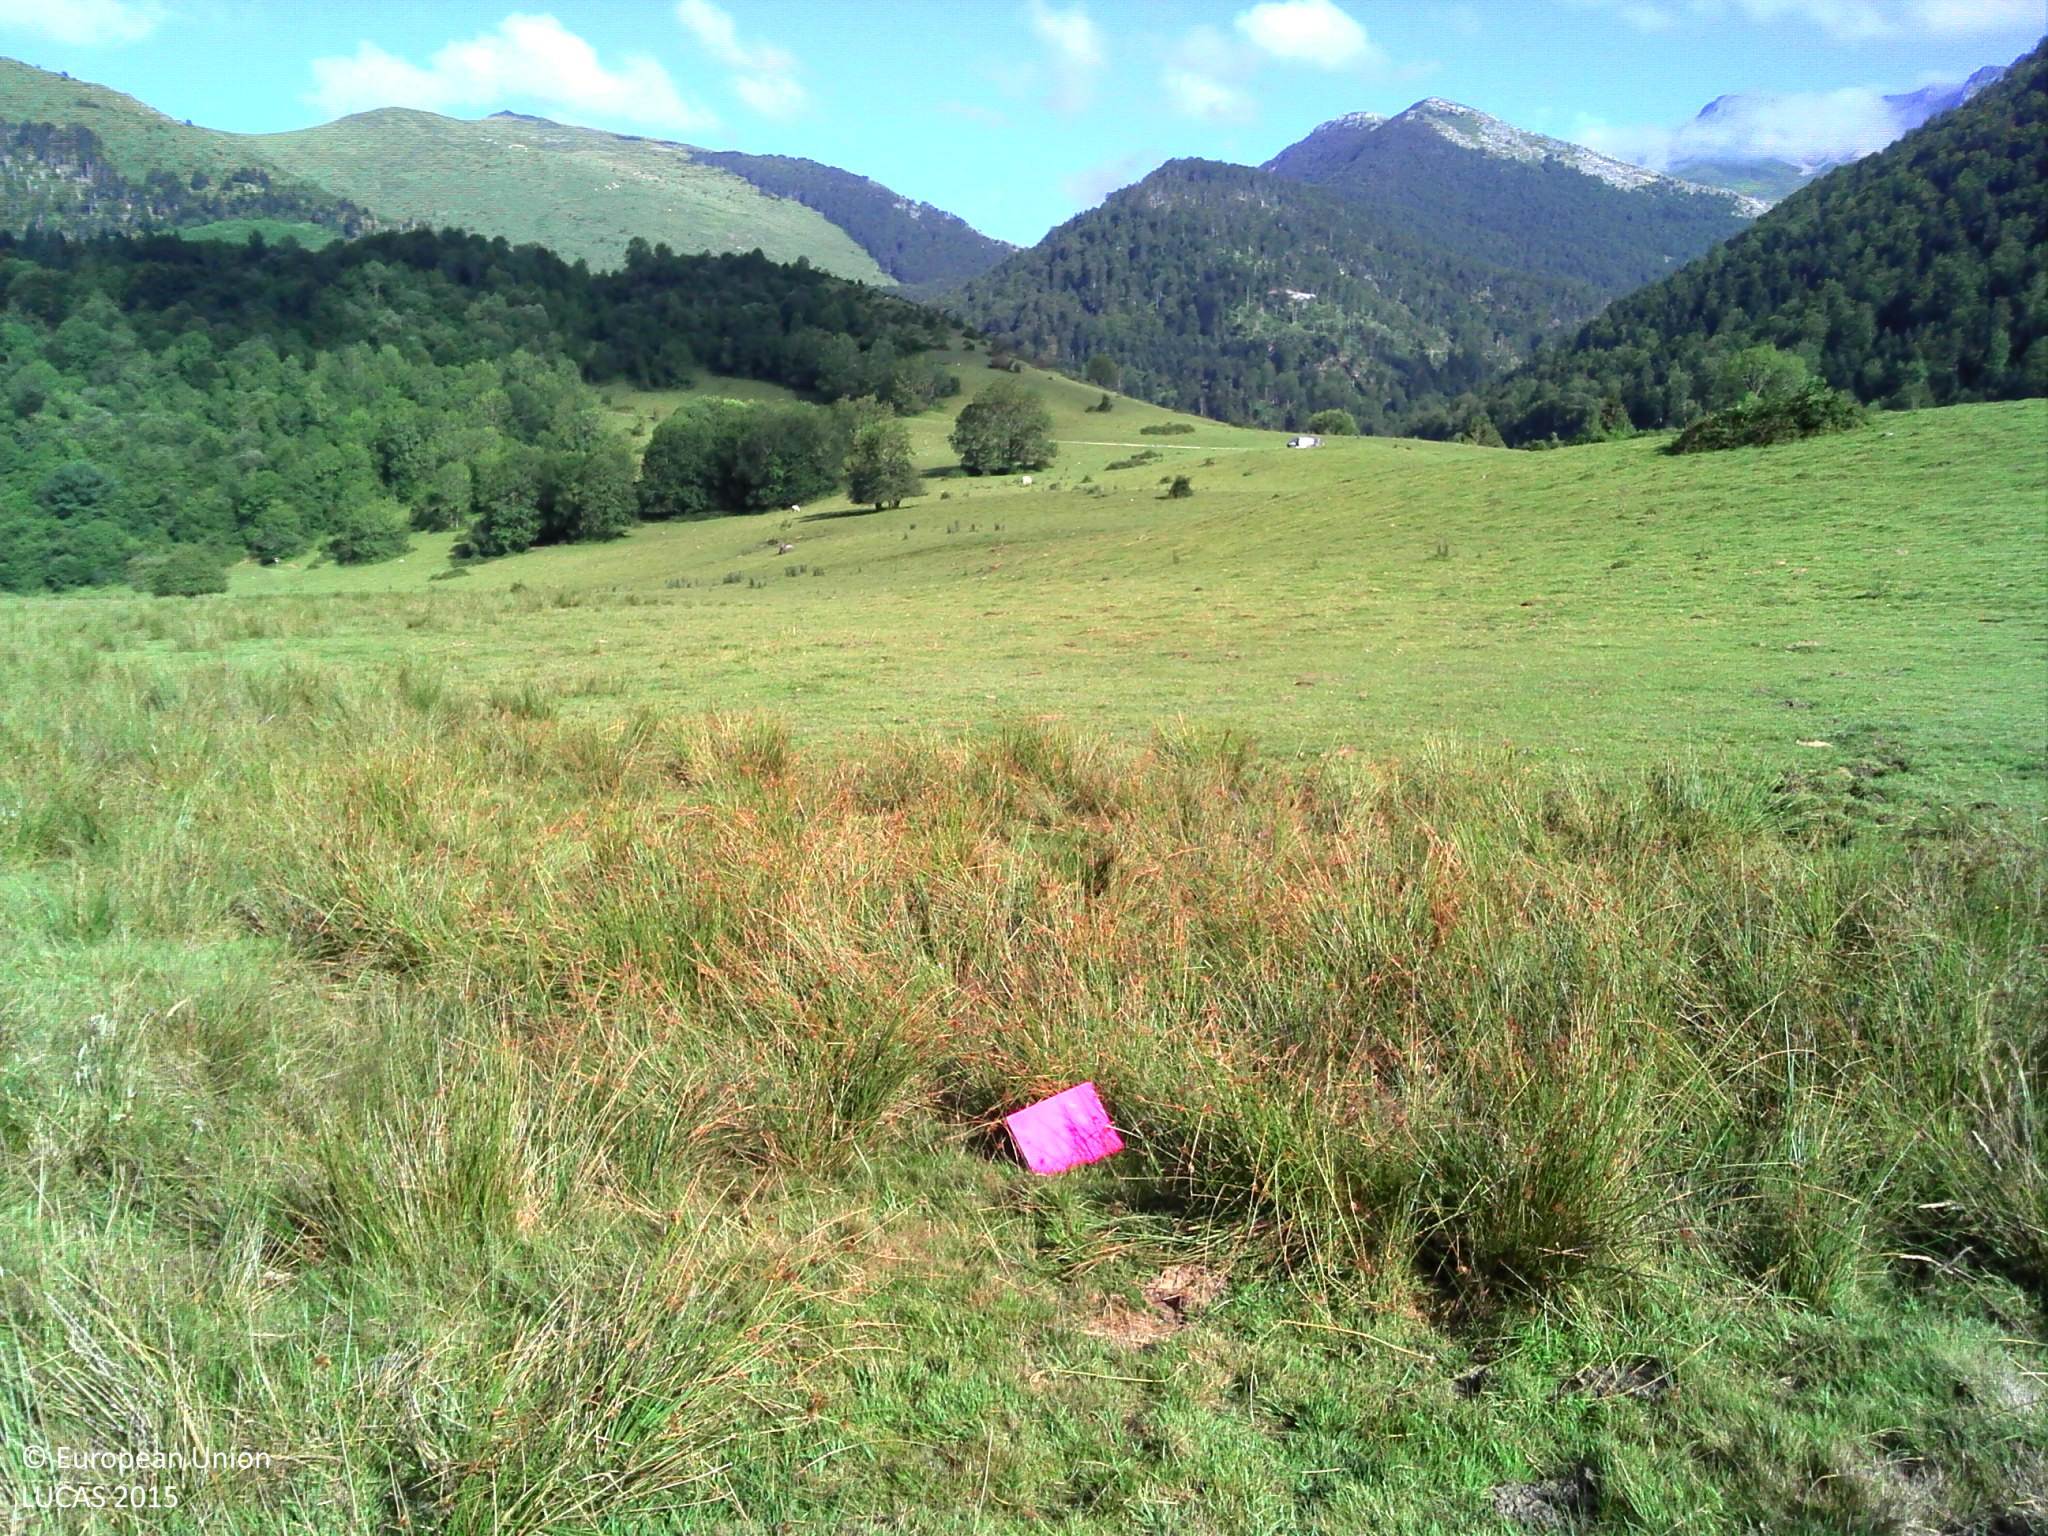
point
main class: Grassland
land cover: Grassland without tree/shrub cover
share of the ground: > 75 %
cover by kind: herbaceous plants 100 %
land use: Agriculture (excluding fallow land and kitchen gardens)
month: July
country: FR
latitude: 43.0650
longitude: -0.3815
